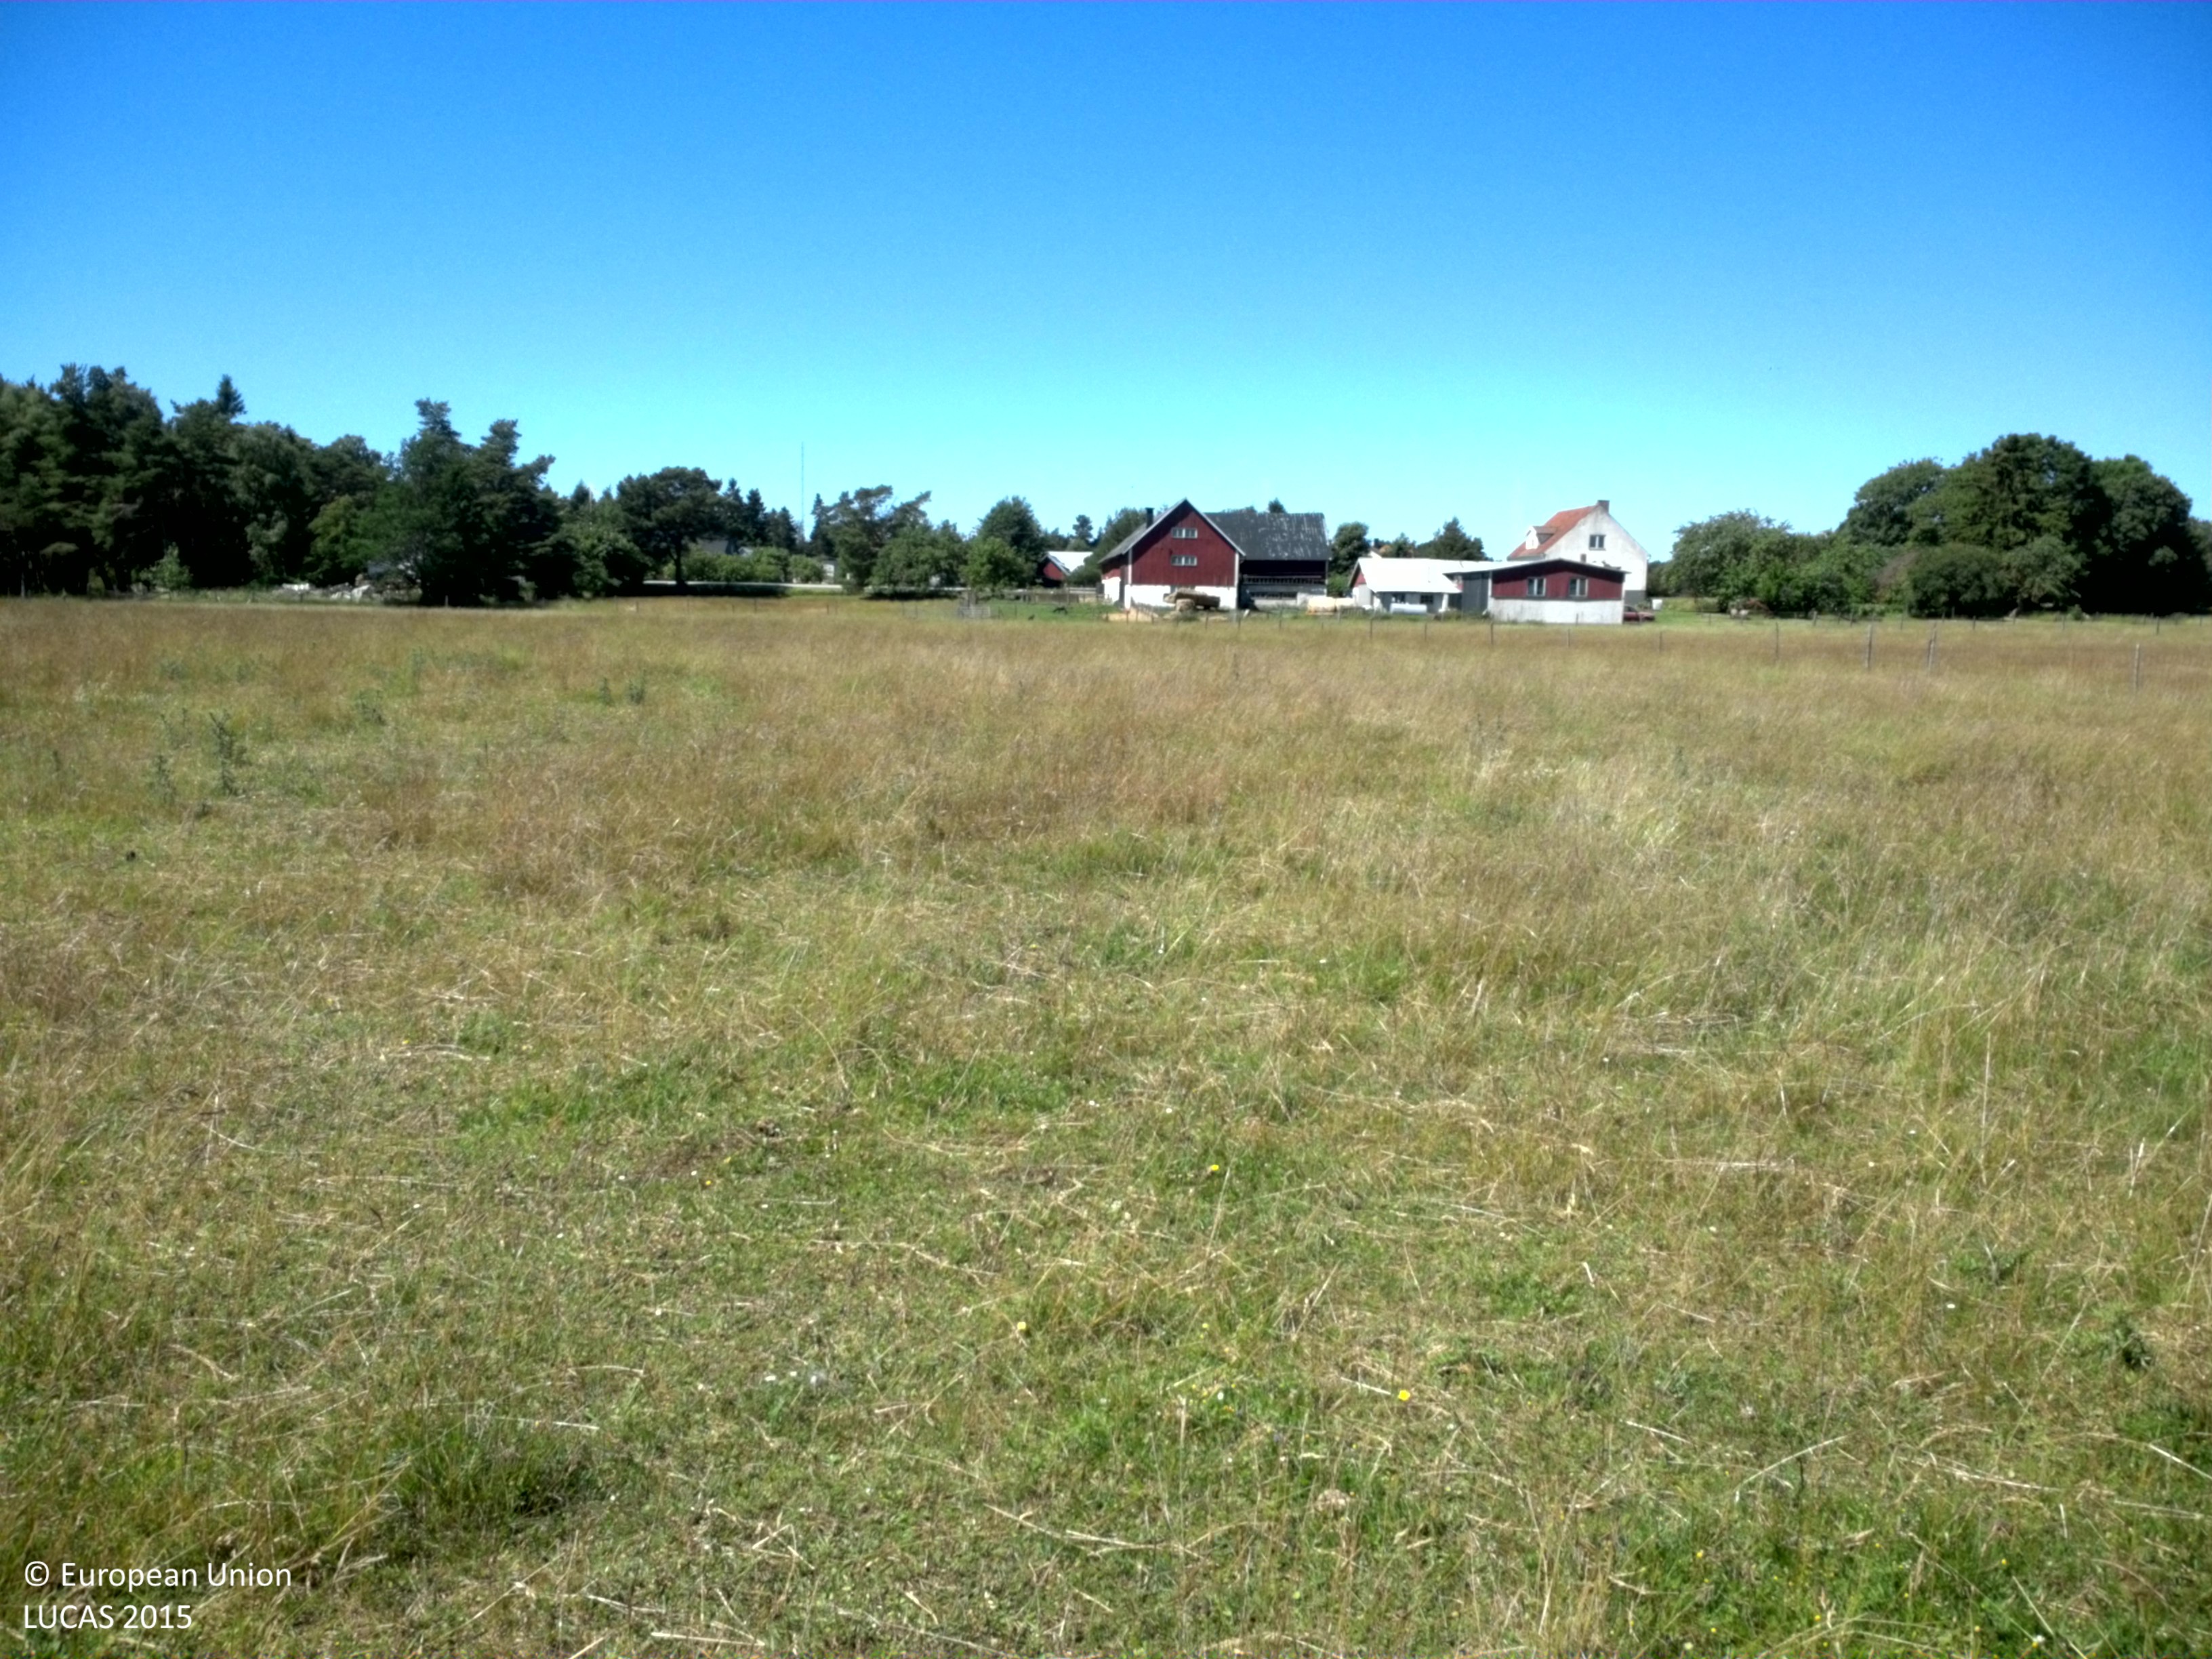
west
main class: Cropland
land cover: Lucerne
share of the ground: > 75 %
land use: Agriculture (excluding fallow land and kitchen gardens)
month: July
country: SE
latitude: 57.7541
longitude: 18.7306
